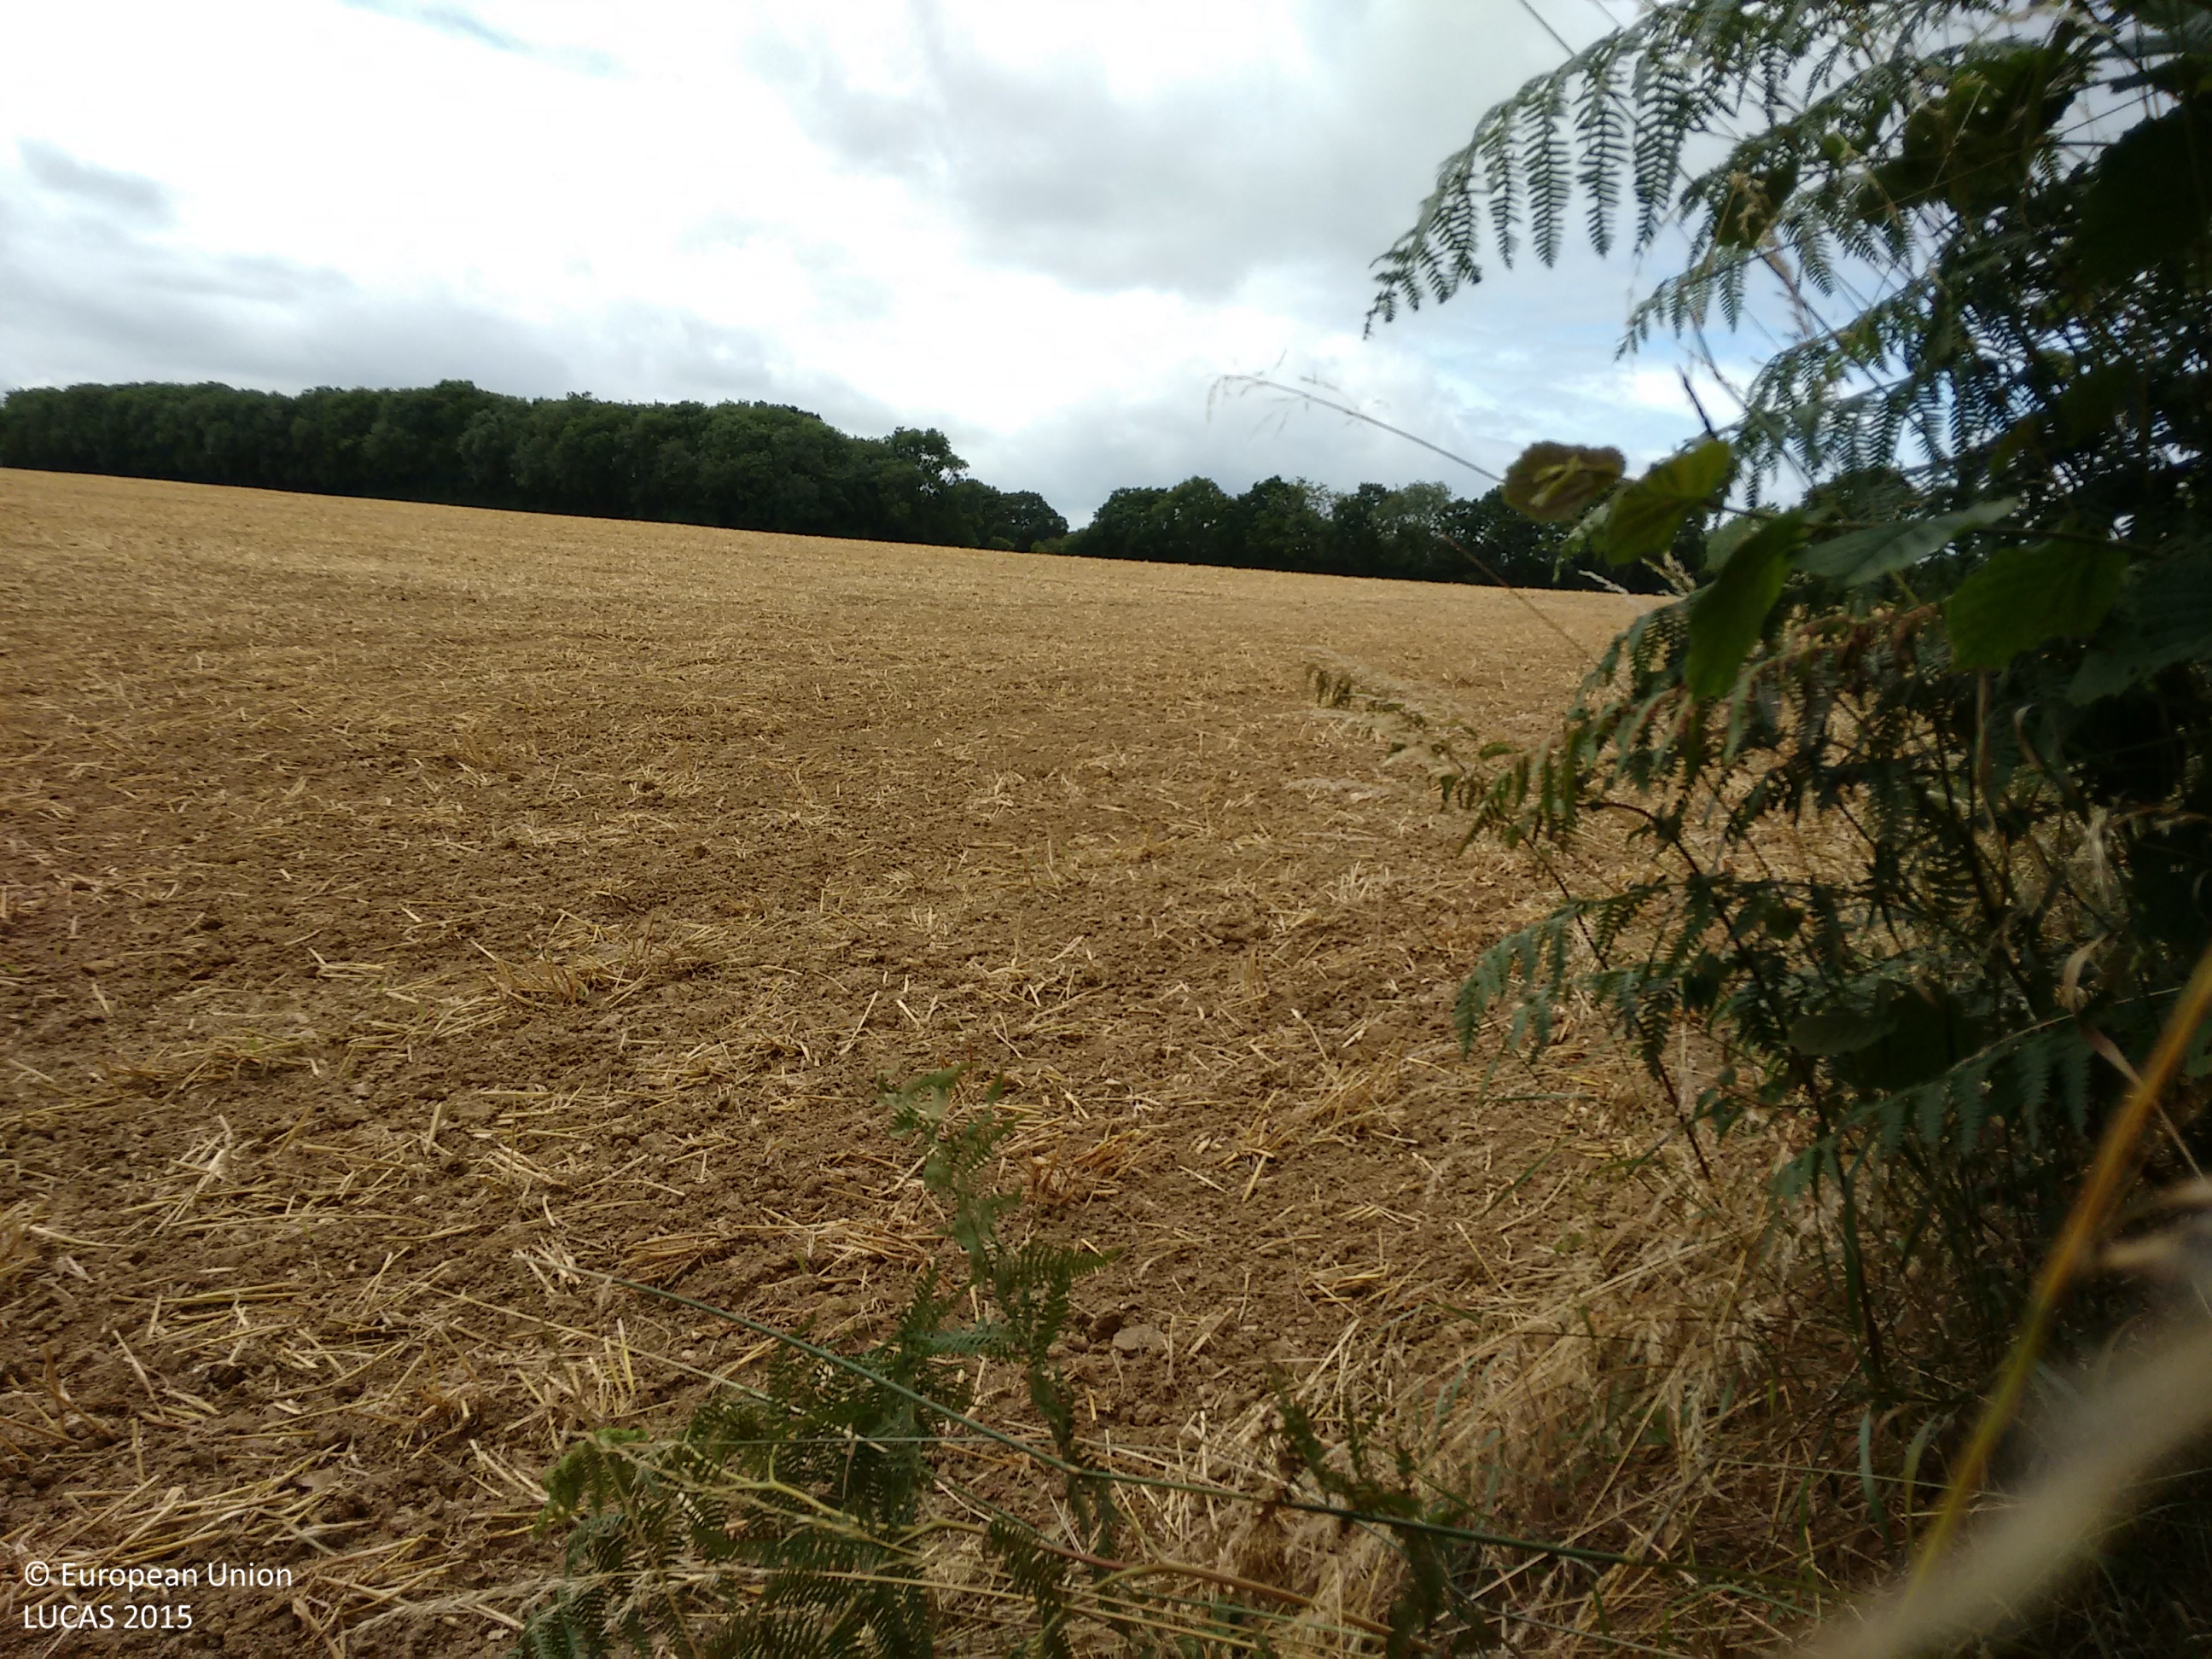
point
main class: Cropland
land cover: Common wheat
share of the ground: > 75 %
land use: Agriculture (excluding fallow land and kitchen gardens)
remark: Harvested field
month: August
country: GB
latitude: 51.2666
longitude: -0.1965
